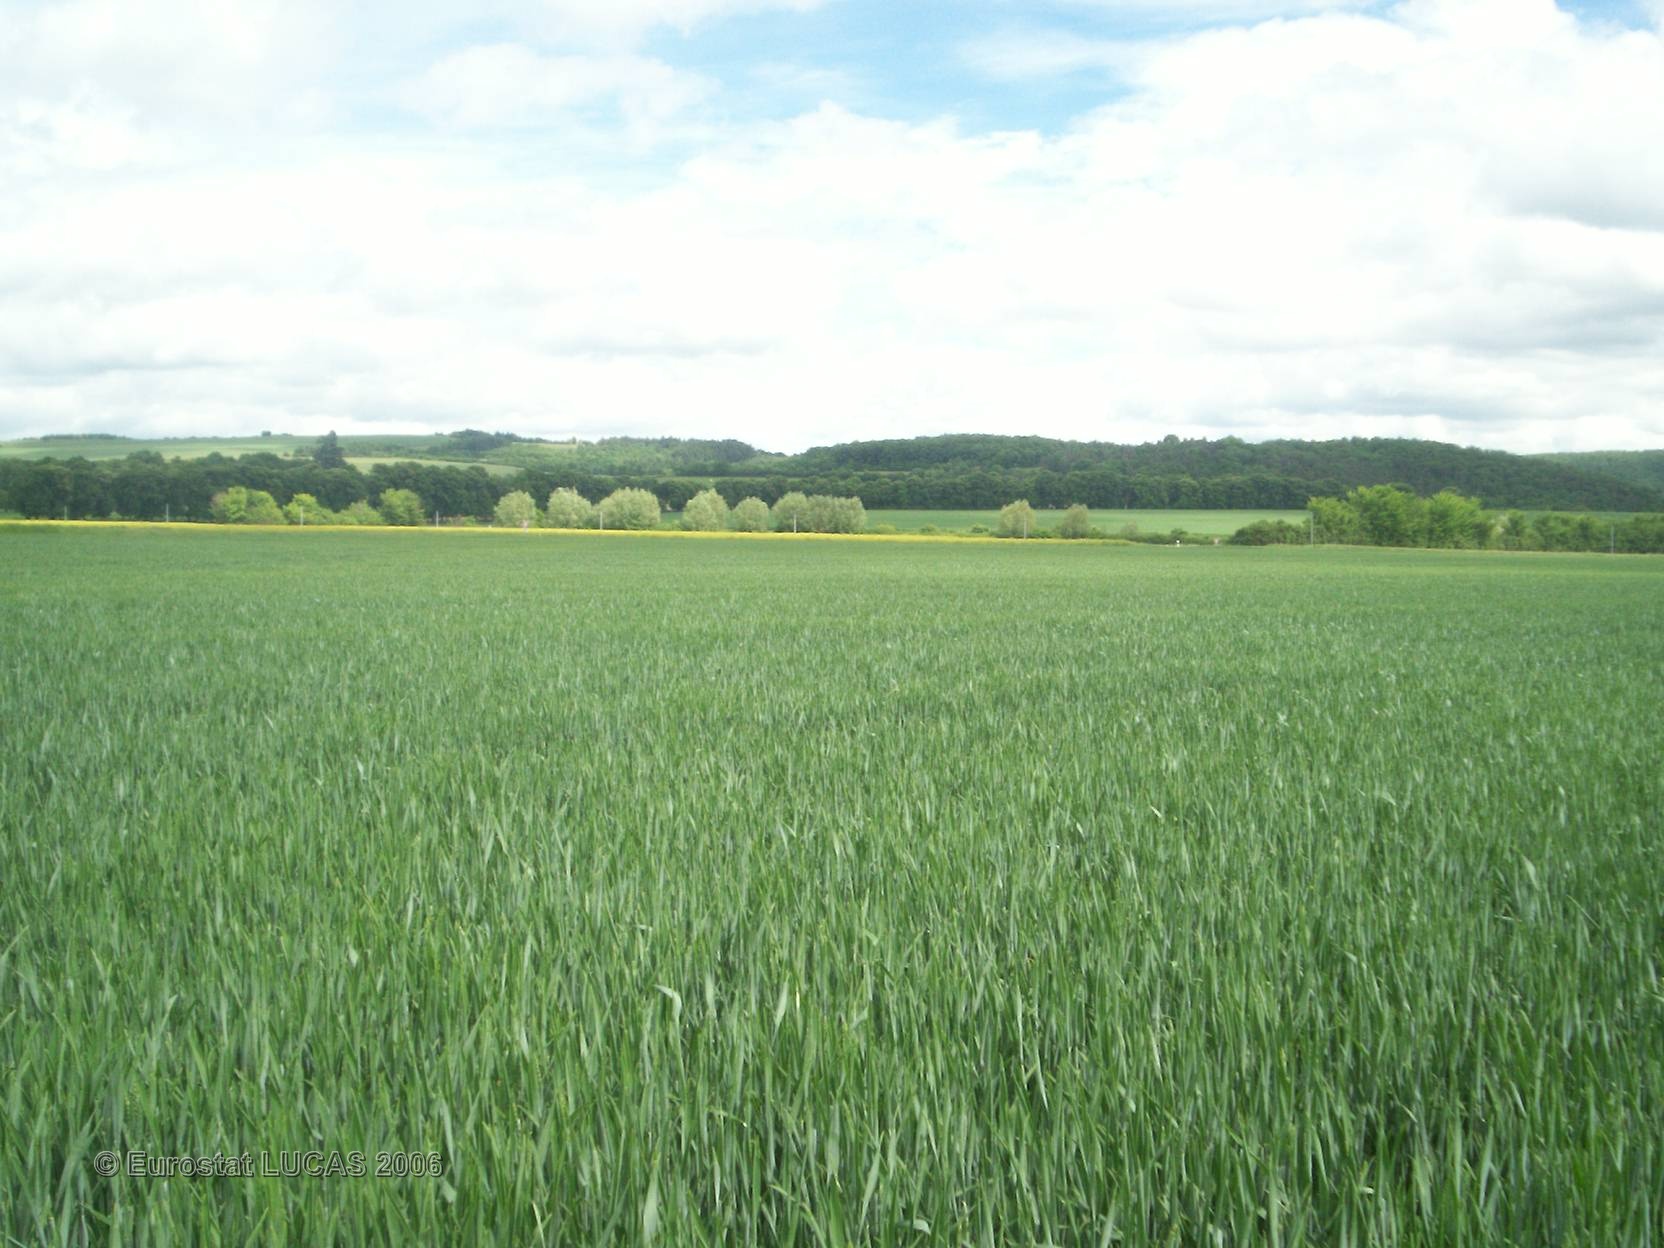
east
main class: Cropland
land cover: Common wheat
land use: Agriculture (excluding fallow land and kitchen gardens)
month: May
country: FR
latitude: 46.1675
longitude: 3.1473
